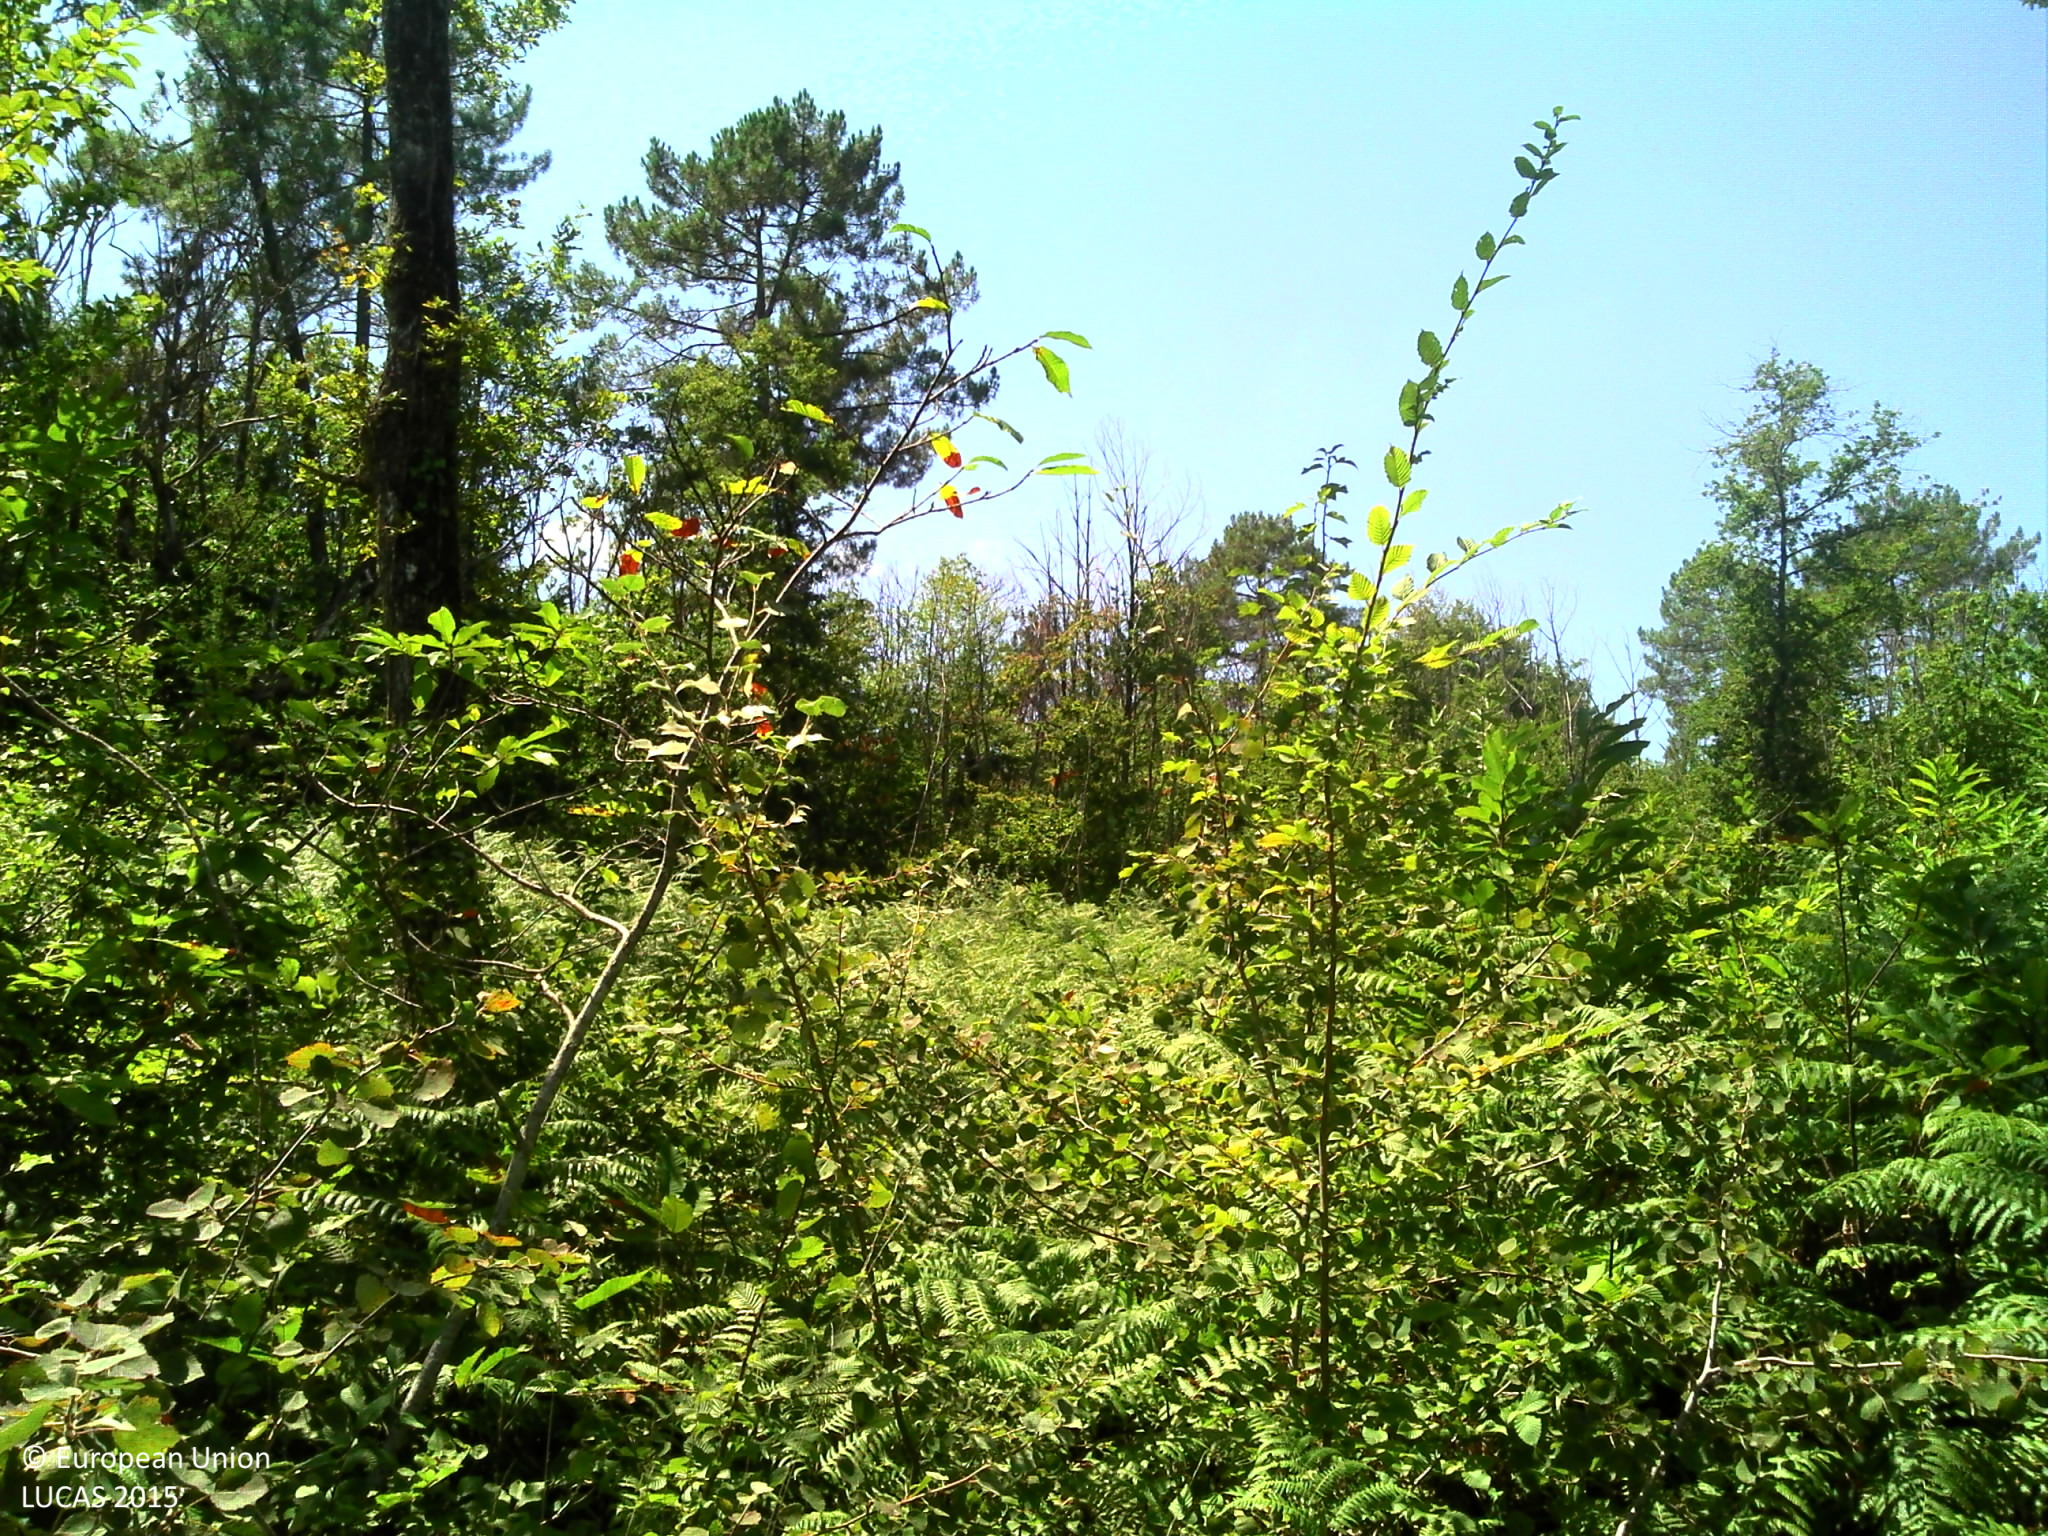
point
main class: Woodland
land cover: Pine dominated mixed woodland
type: coniferous forest of the mediterranean region
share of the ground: 25 - 50 %
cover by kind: herbaceous plants 40 %, broadleaved forest trees 30 %, shrubs 20 %, coniferous forest trees 10 %
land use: Forestry
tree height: < 5 m
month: August
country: FR
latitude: 45.2541
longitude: 0.6749
